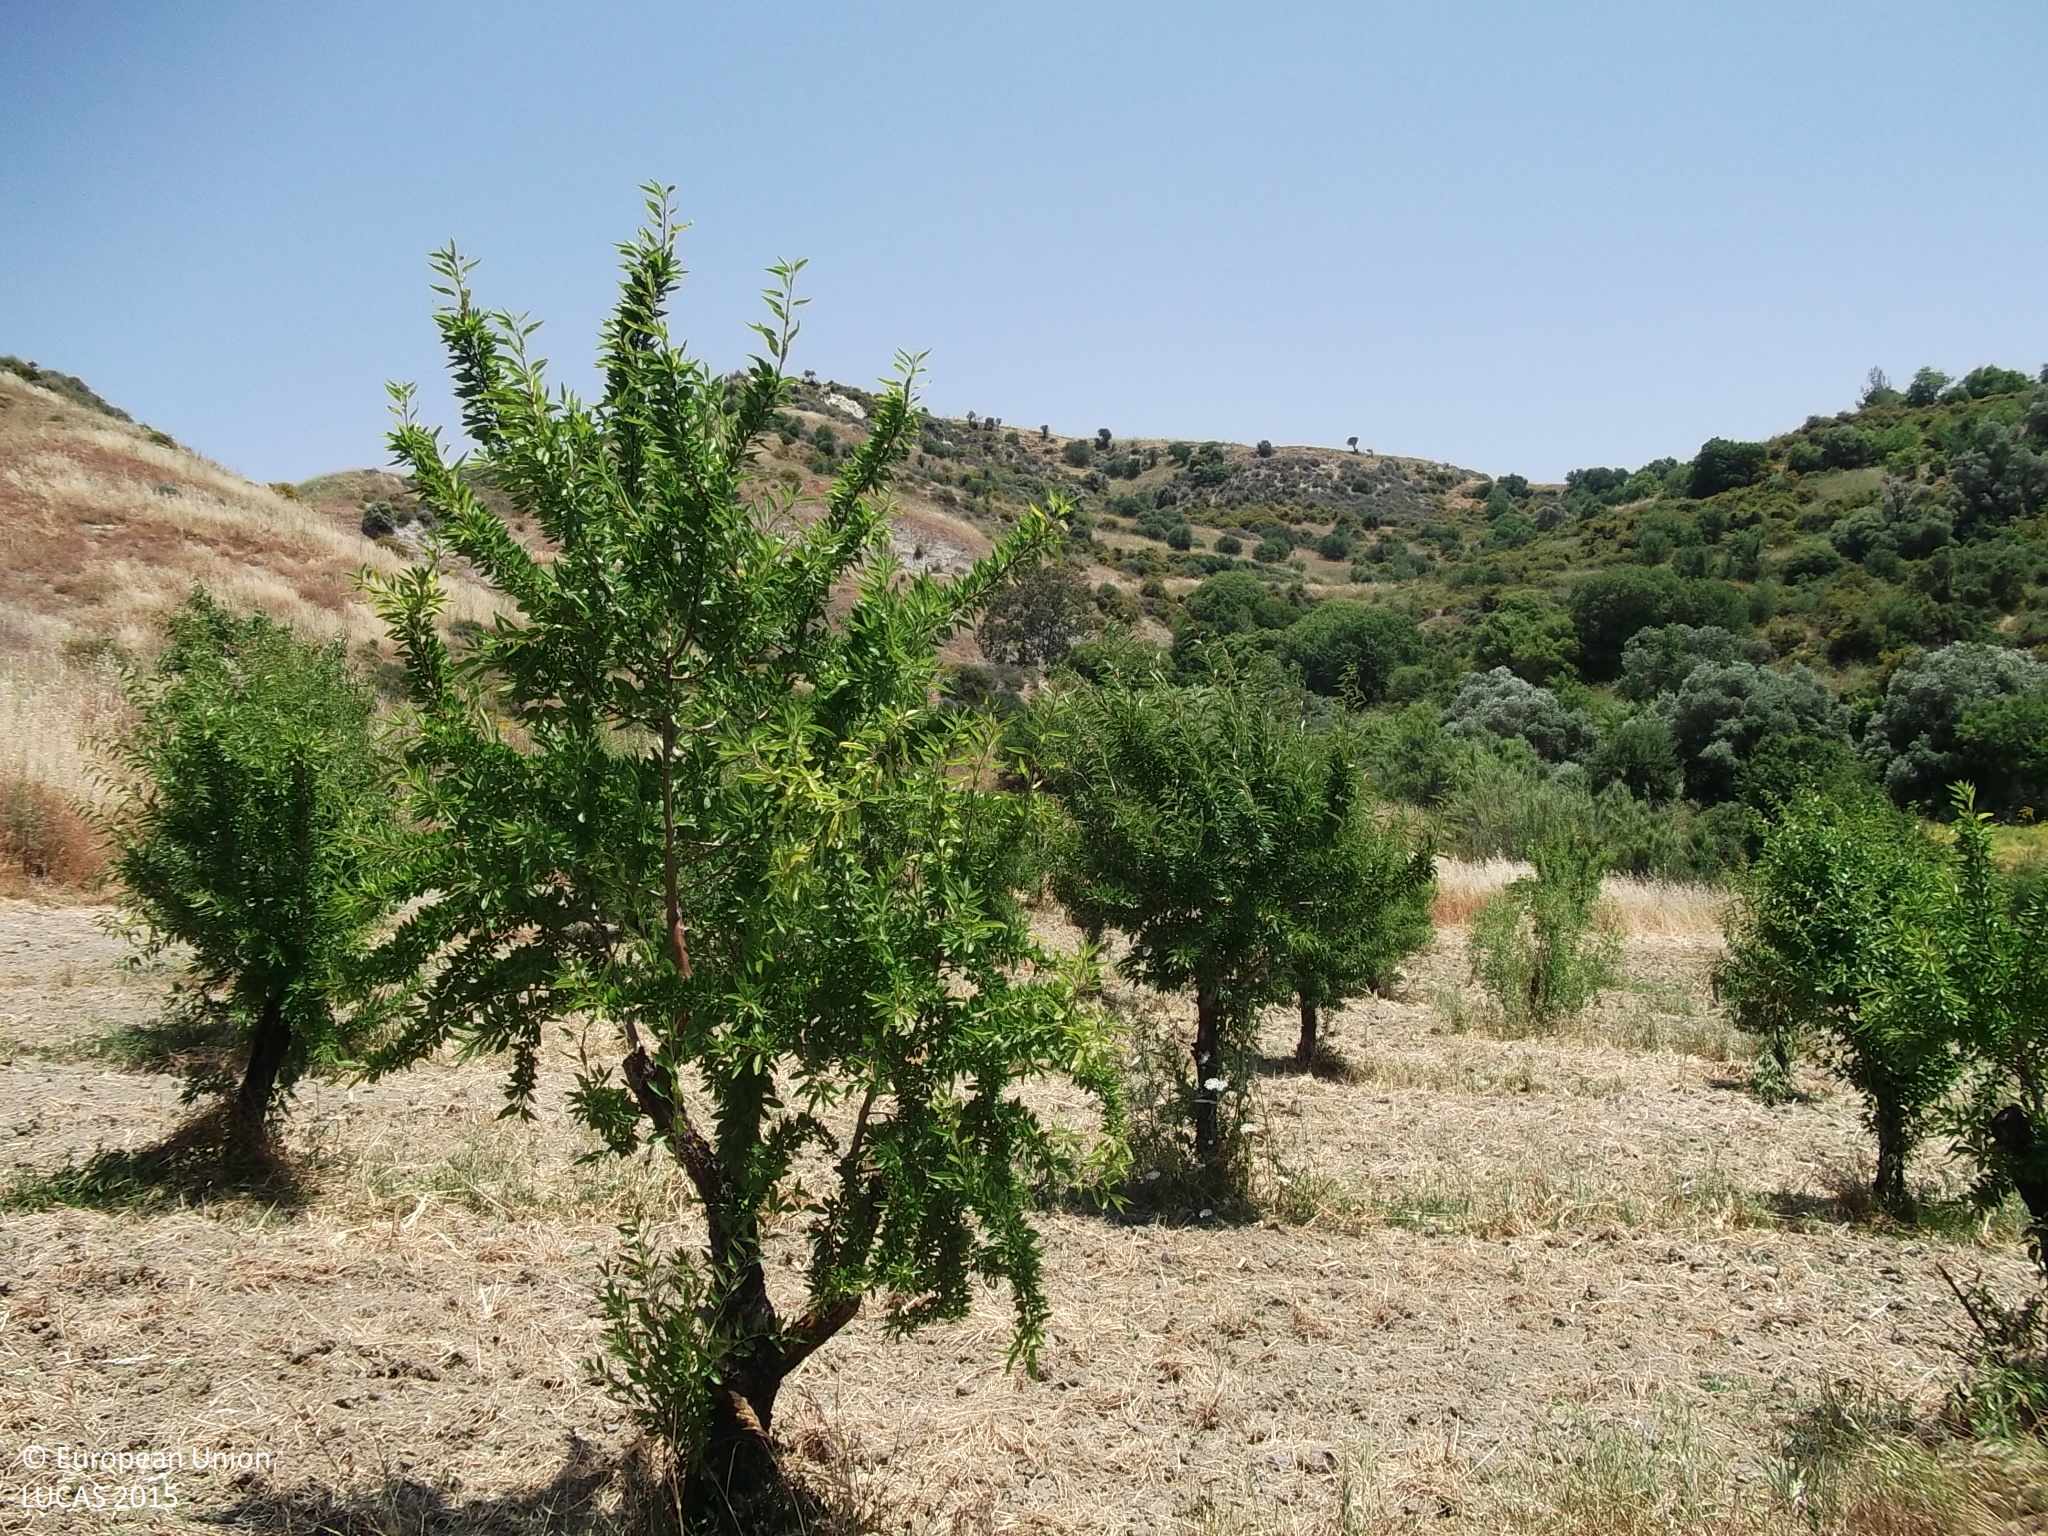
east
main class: Cropland
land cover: Other fruit trees and berries
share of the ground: 25 - 50 %
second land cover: Other bare soil
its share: > 75 %
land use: Agriculture (excluding fallow land and kitchen gardens)
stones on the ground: 10 - 25 %
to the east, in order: Other fruit trees and berries; Other bare soil; Grassland without tree/shrub cover; Grassland with sparse tree/shrub cover; Other bare soil; Grassland without tree/shrub cover; Shrubland without tree cover; Grassland without tree/shrub cover
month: May
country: CY
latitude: 34.9182
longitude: 32.5834
